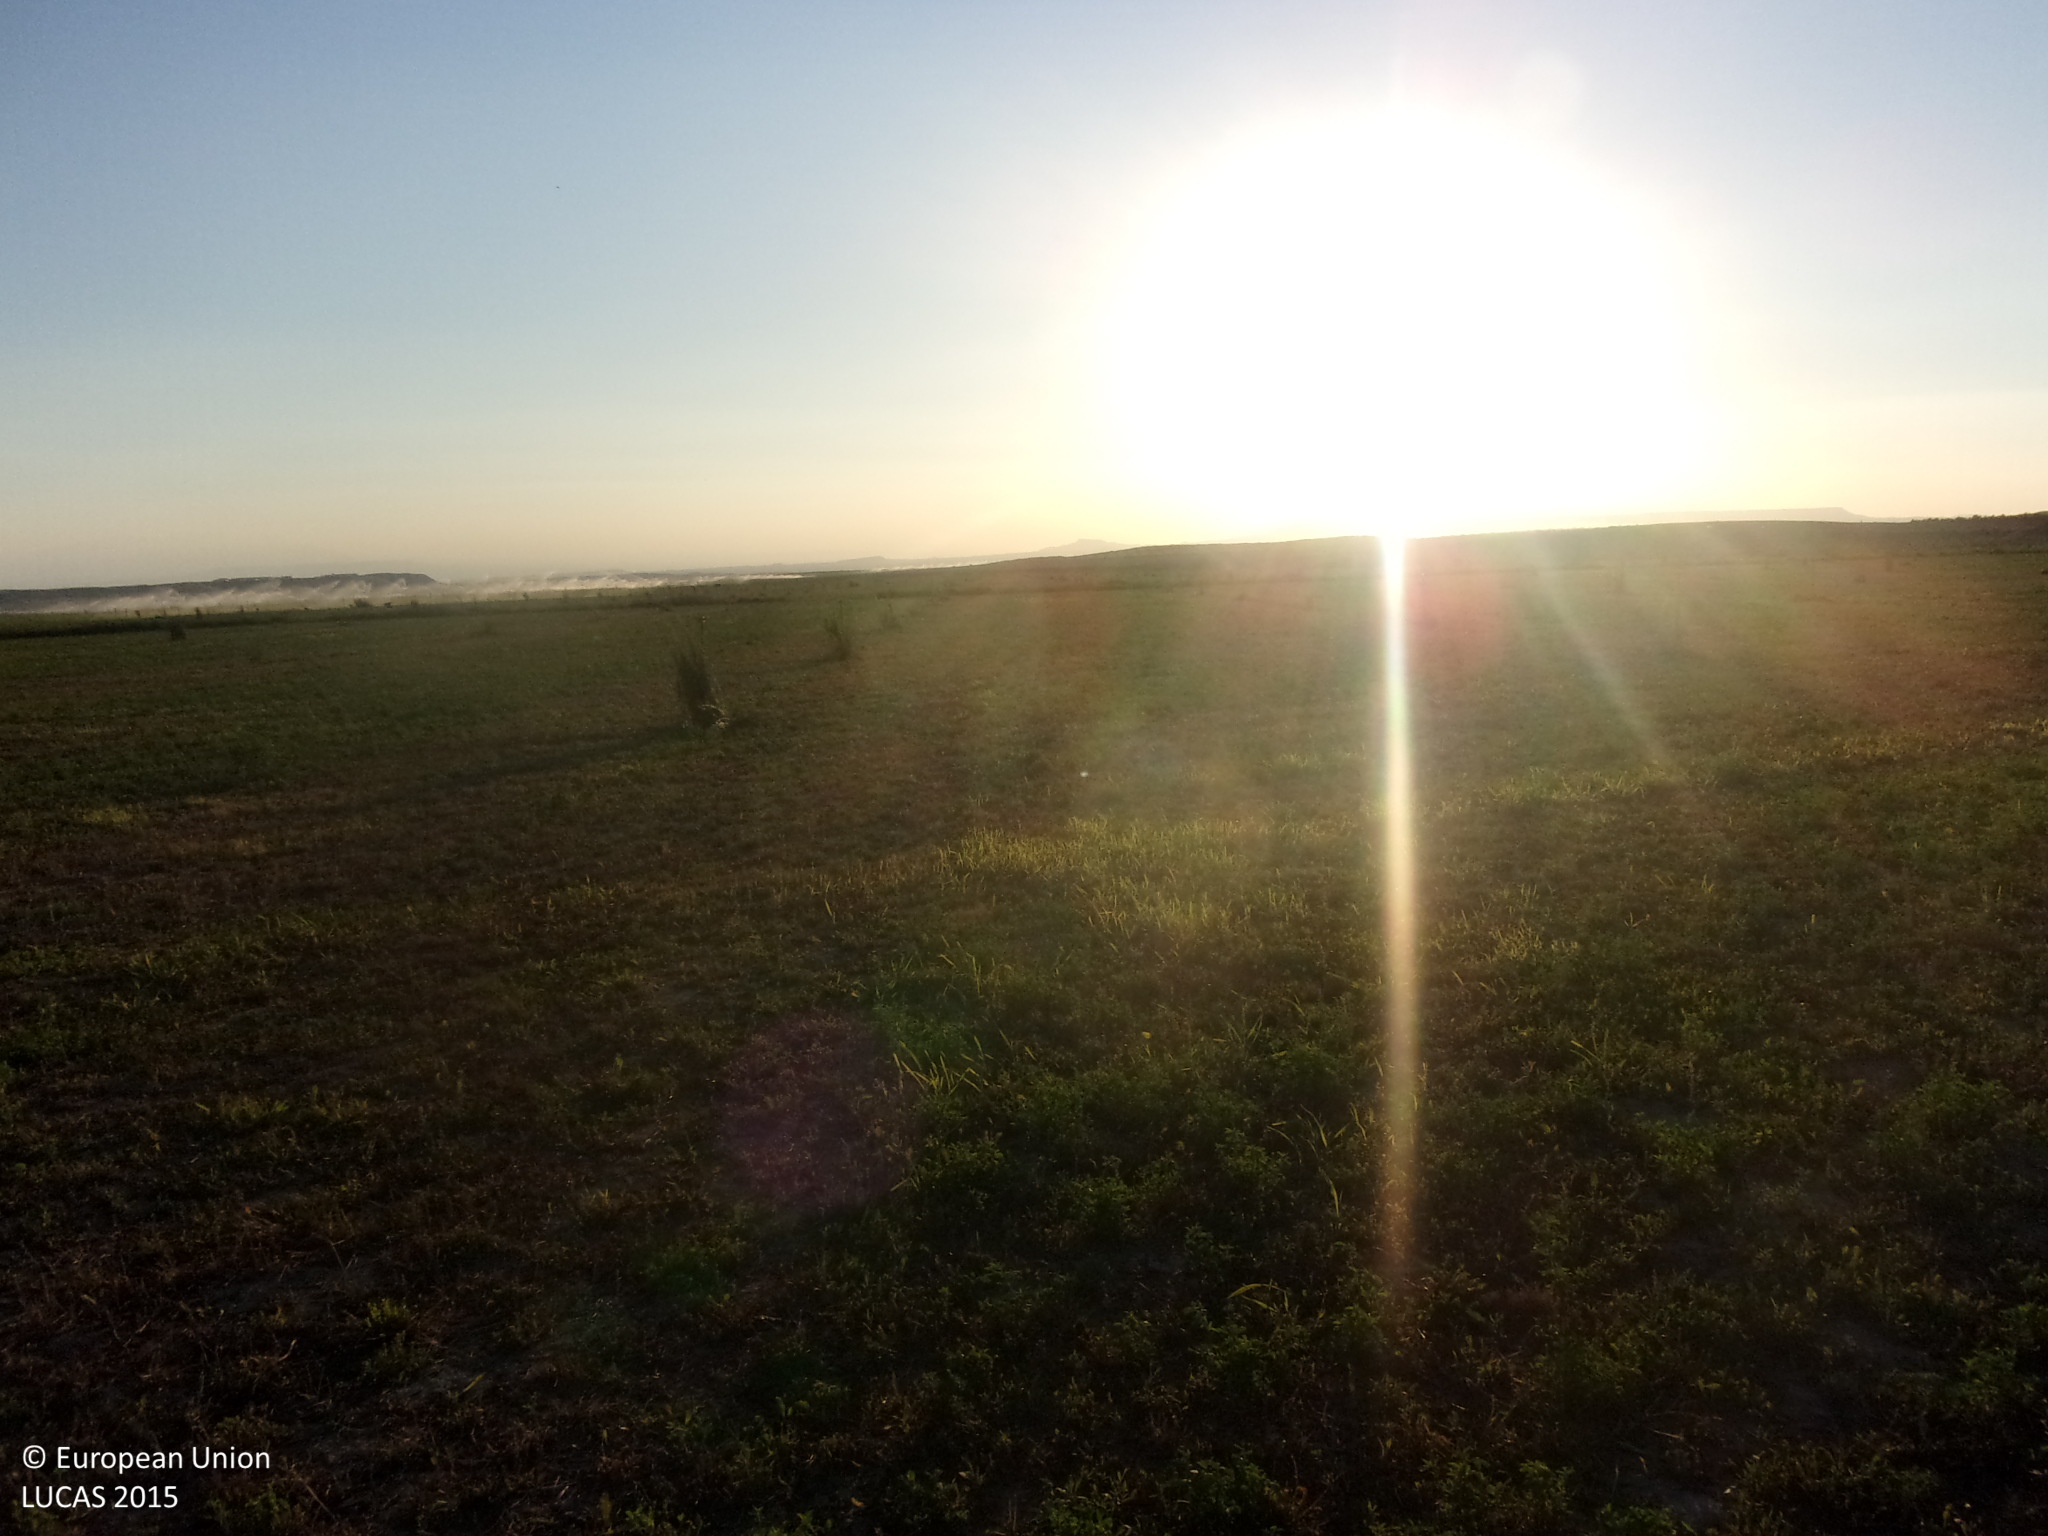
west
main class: Cropland
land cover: Lucerne
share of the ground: > 75 %
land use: Agriculture (excluding fallow land and kitchen gardens)
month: July
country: ES
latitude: 41.9700
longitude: -1.0919
